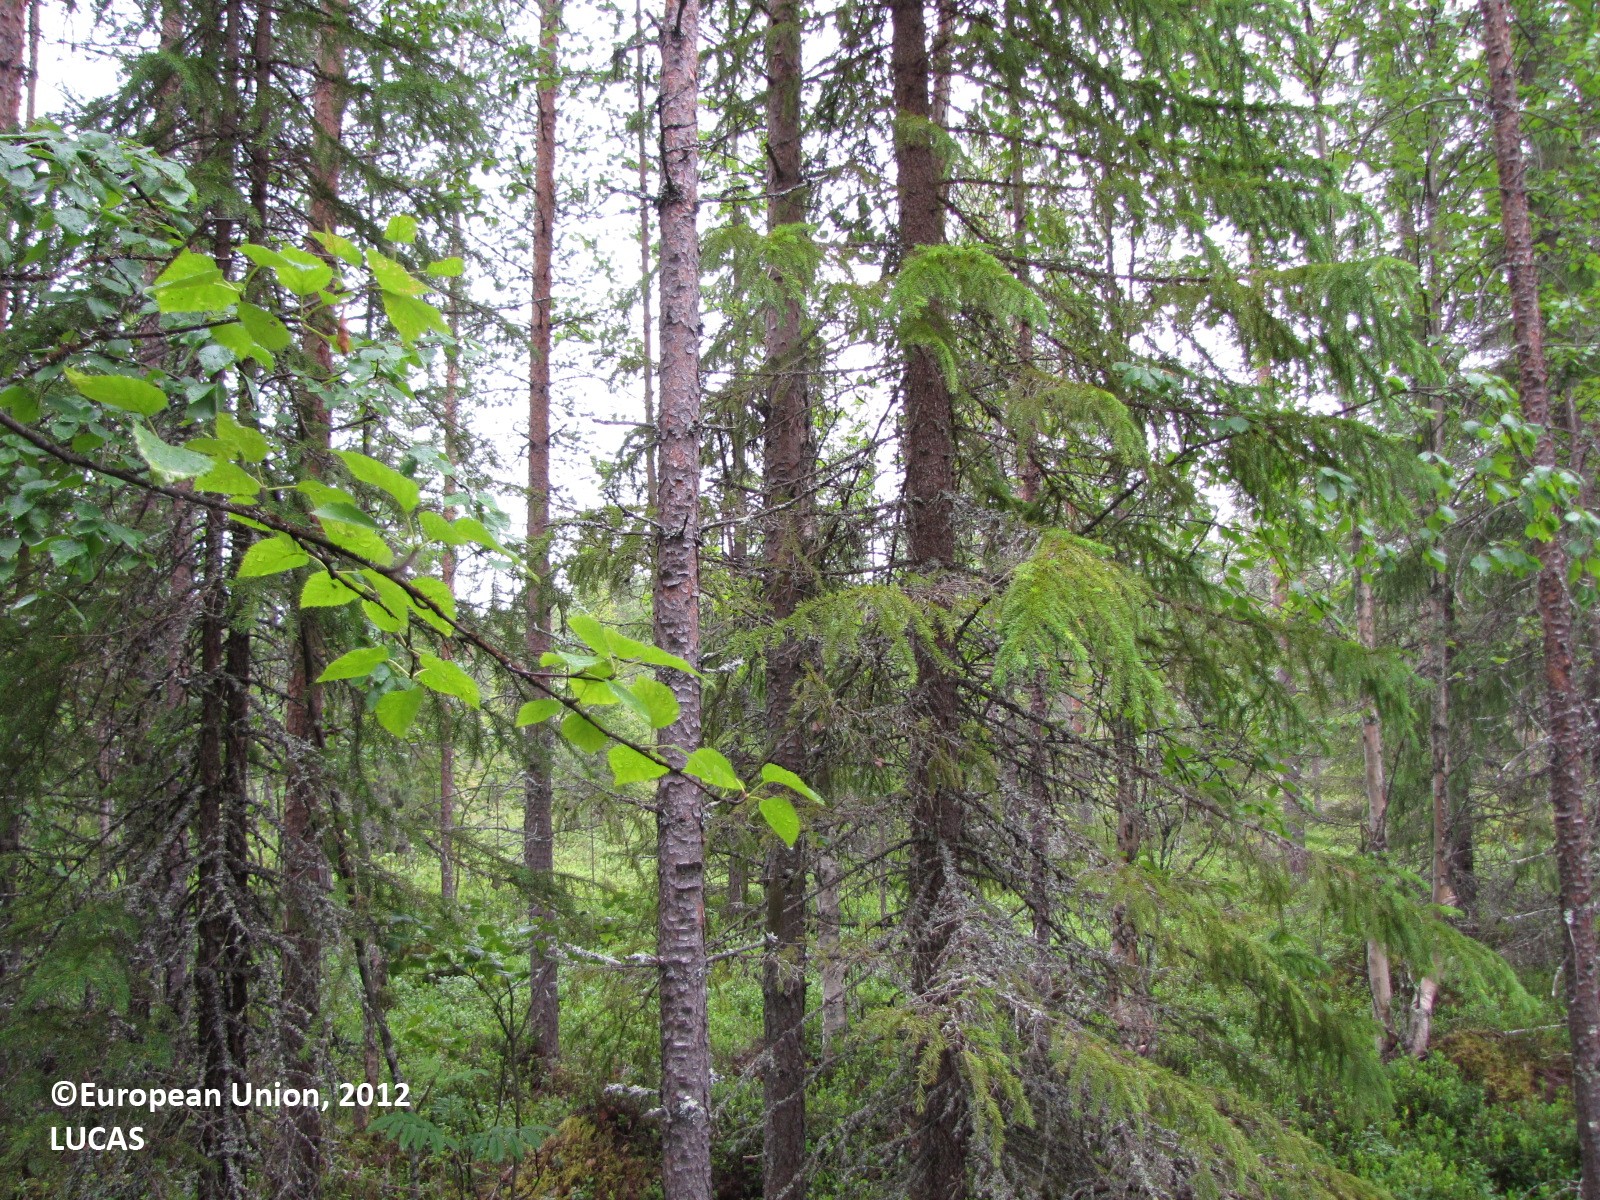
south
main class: Woodland
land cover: Other coniferous woodland
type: boreal forest
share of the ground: 50 - 75 %
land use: Forestry
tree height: > 5 m
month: July
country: FI
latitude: 66.6281
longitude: 24.8916
